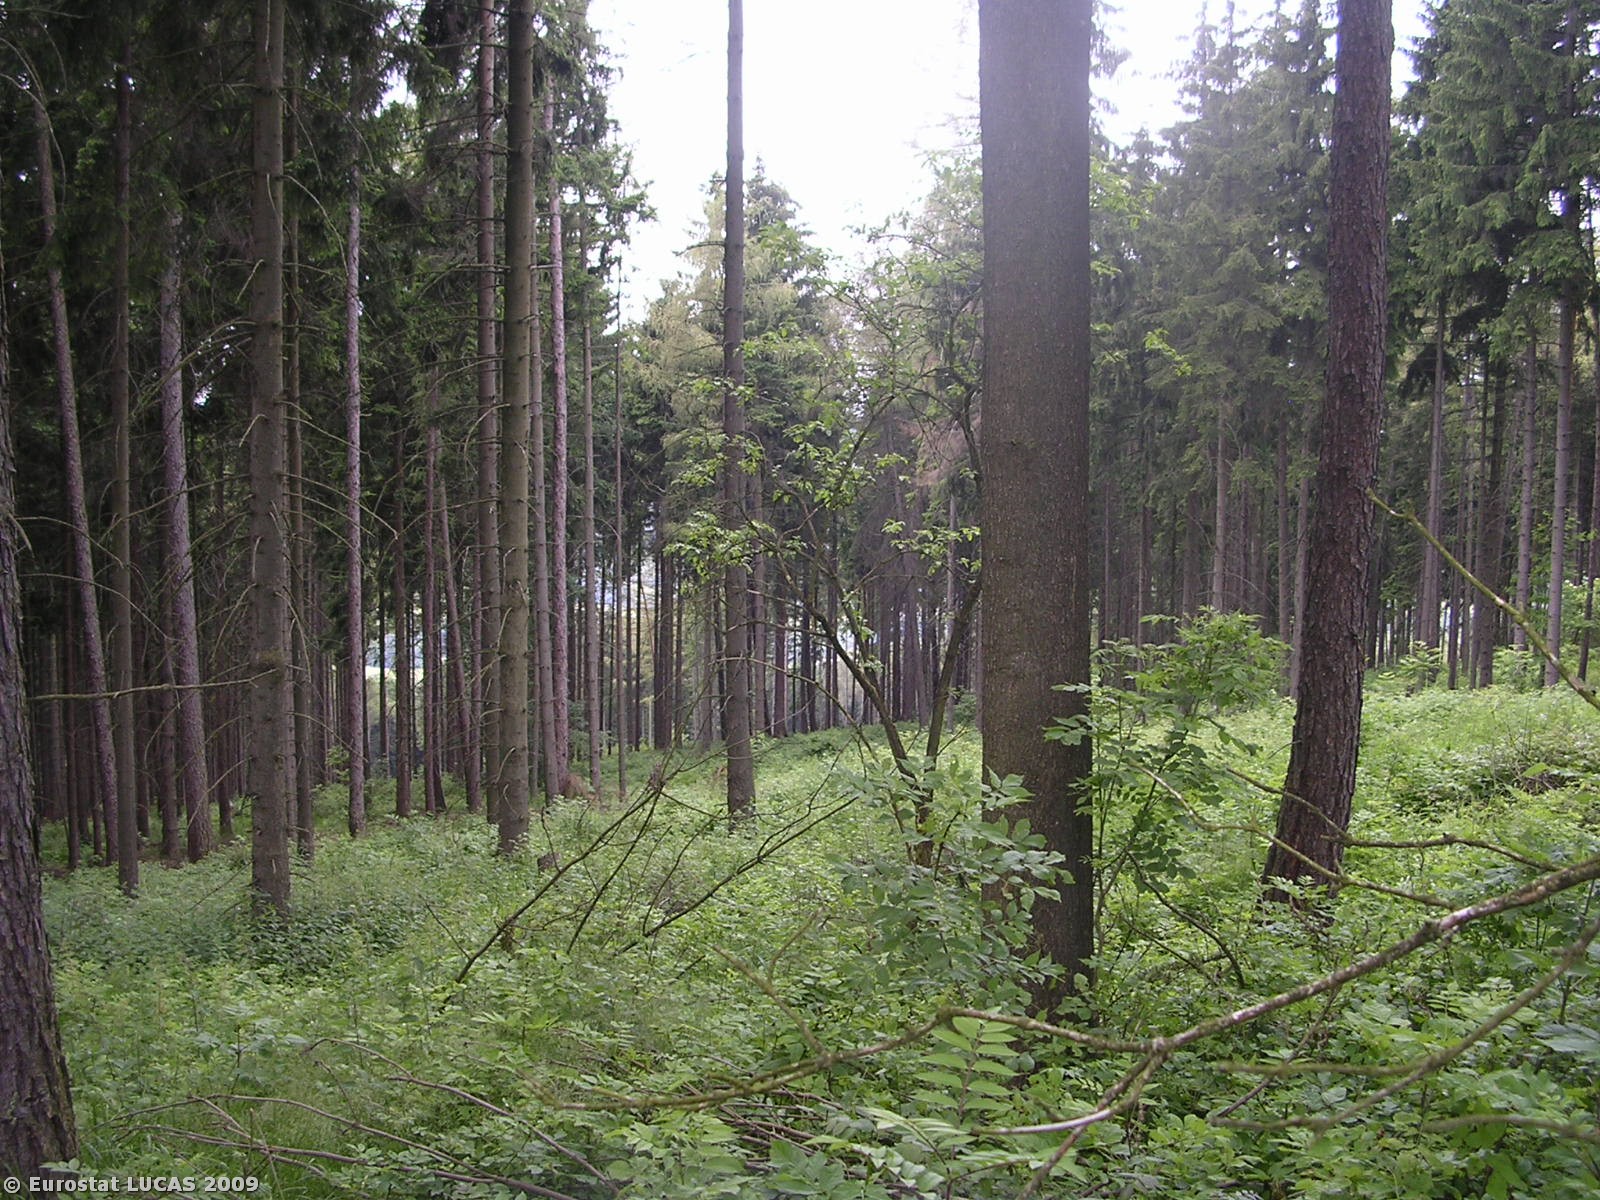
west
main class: Woodland
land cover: Mixed woodland
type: hemiboreal forest and nemoral coniferous forest and mixed broadleaved-coniferous forest
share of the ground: > 75 %
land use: Forestry
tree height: > 5 m
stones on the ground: < 10 %
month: June
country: CZ
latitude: 50.6291
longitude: 14.2000
